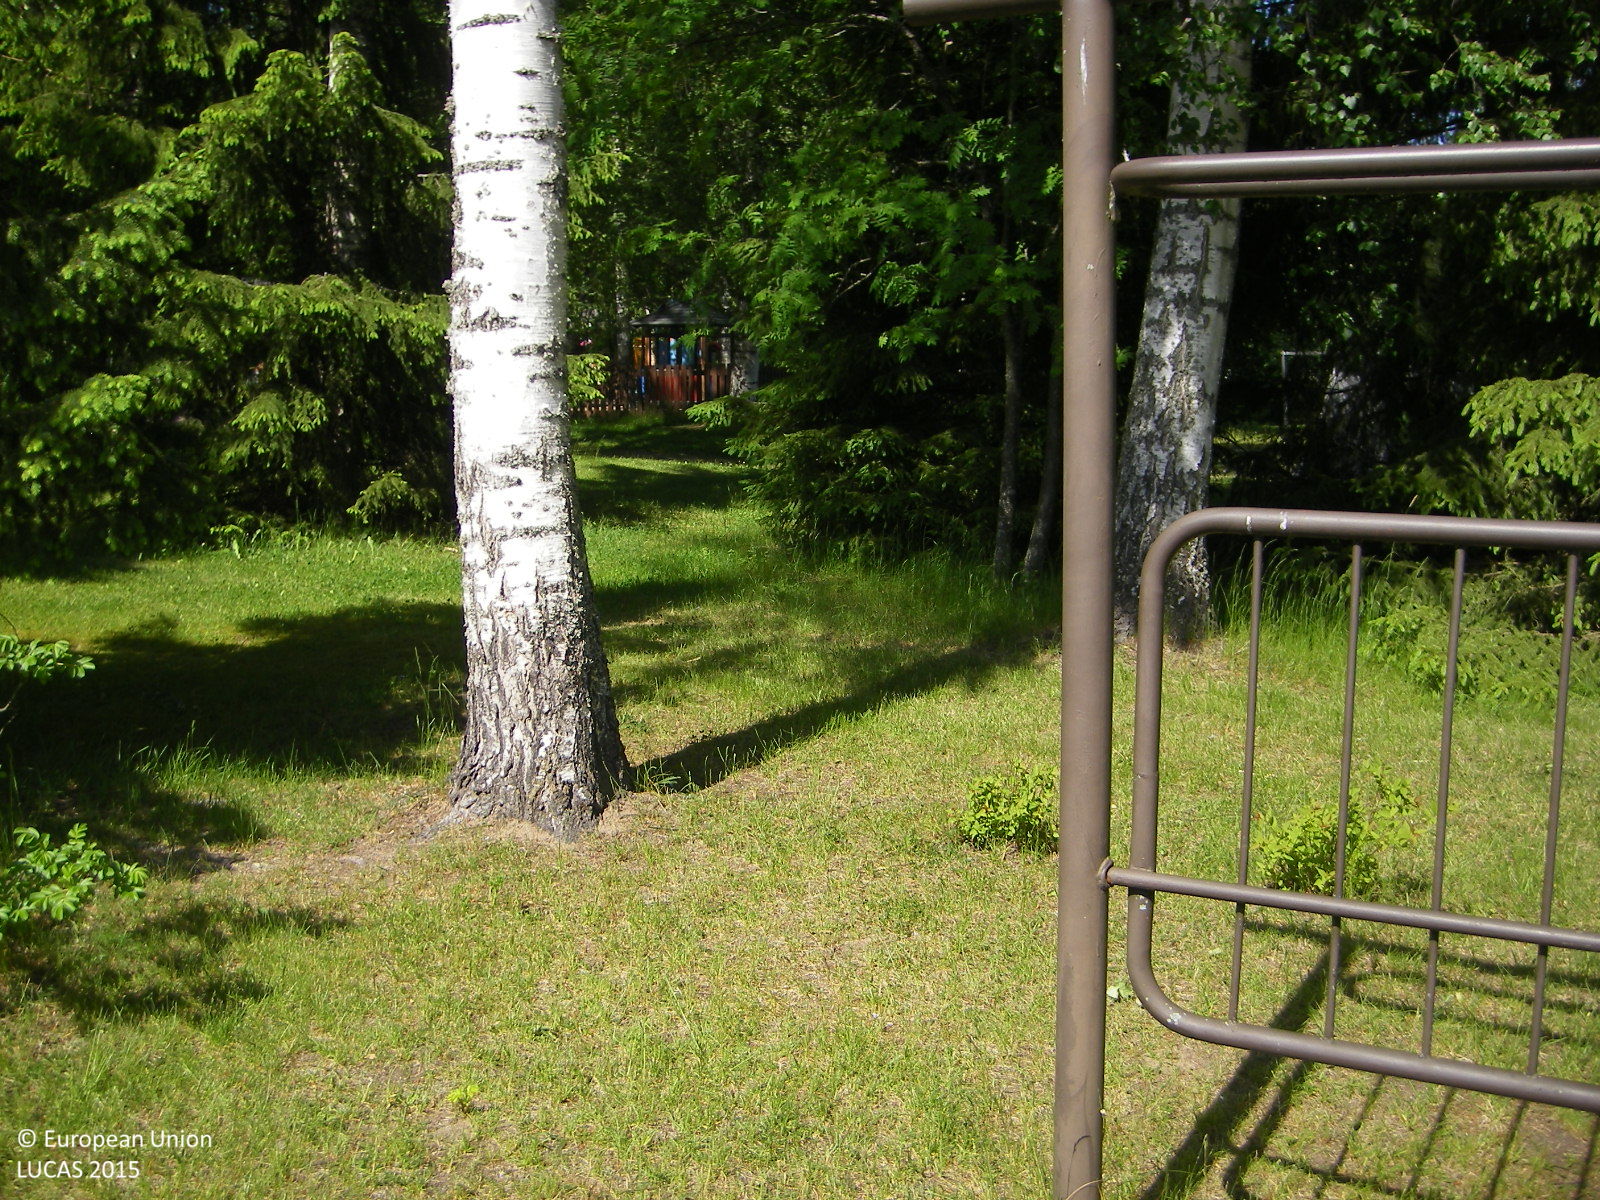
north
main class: Grassland
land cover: Grassland with sparse tree/shrub cover
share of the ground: > 75 %
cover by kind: herbaceous plants 85 %, broadleaved forest trees 5 %, shrubs 5 %, unconsolidated bare surface 5 %
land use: Residential
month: June
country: FI
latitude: 60.3707
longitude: 24.4126
